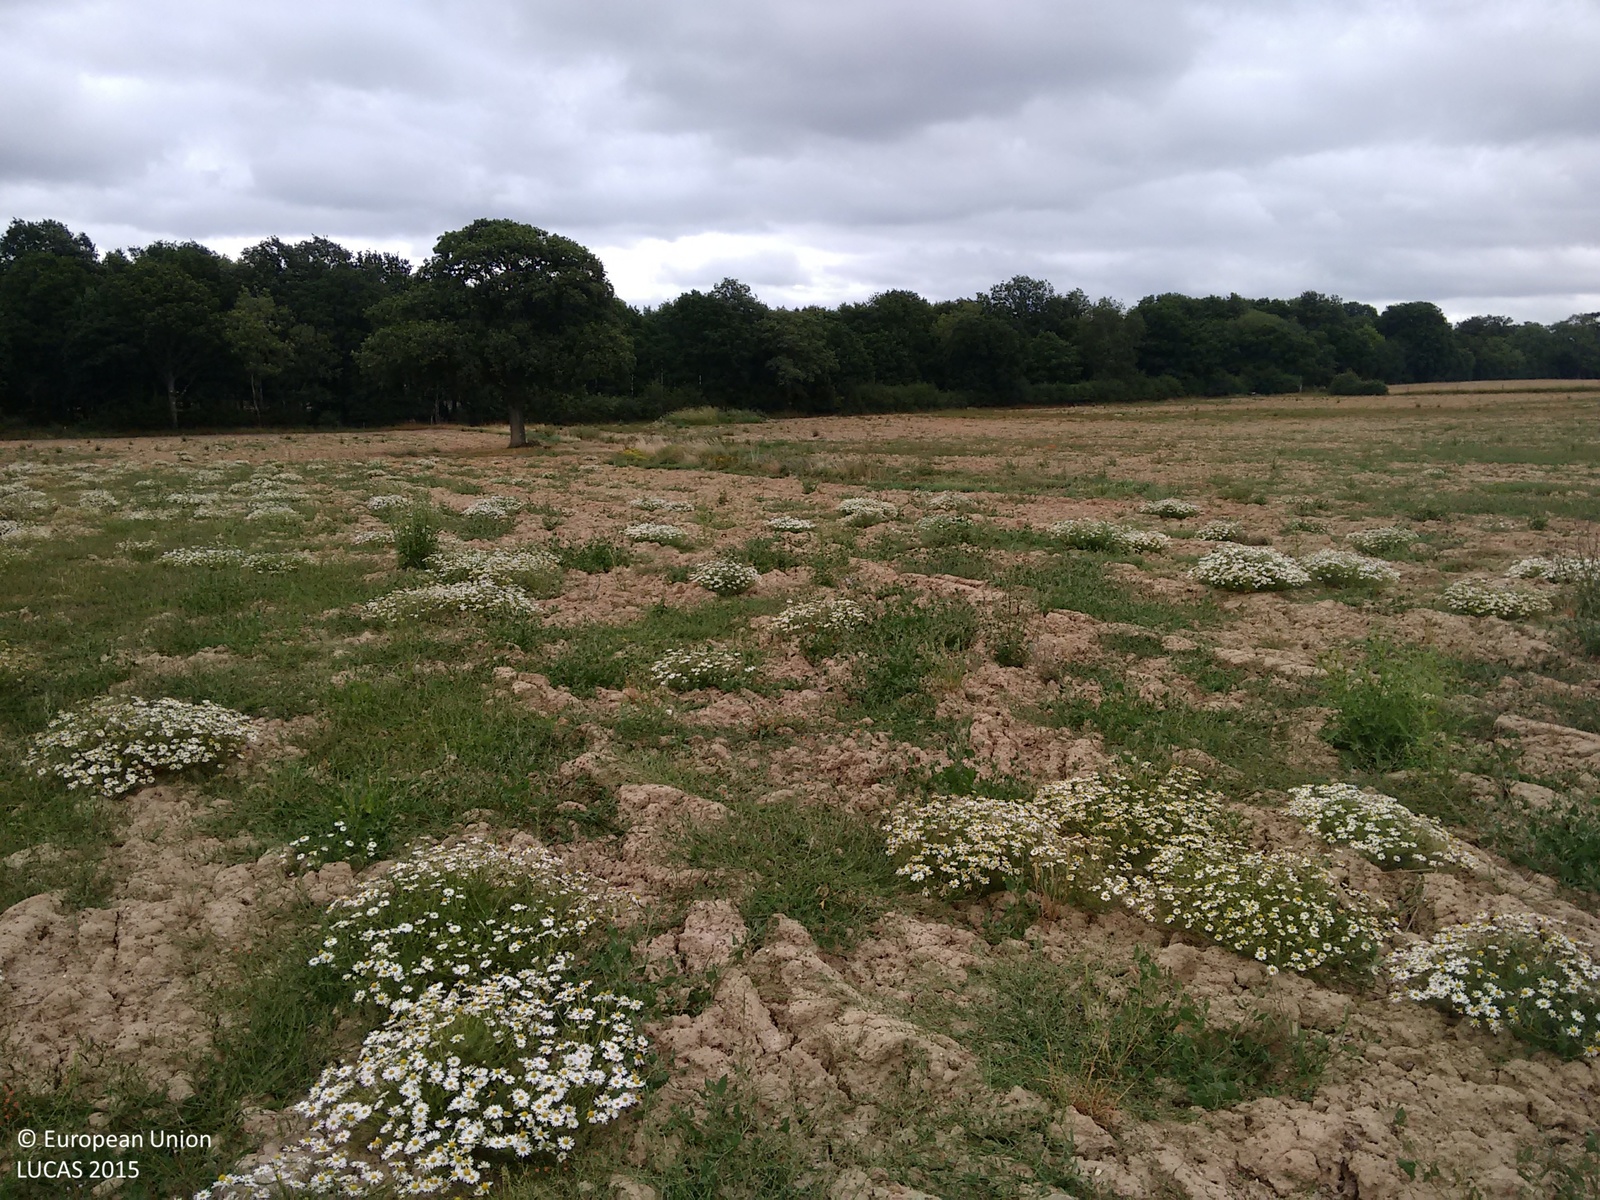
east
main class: Grassland
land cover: Spontaneously vegetated surfaces
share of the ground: 25 - 50 %
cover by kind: herbaceous plants 60 %, unconsolidated bare surface 40 %
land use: Fallow land
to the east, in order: Spontaneously vegetated surfaces; Ditches and canals; Spontaneously vegetated surfaces; Fences; Managed hedges; Ditches and canals; Tracks; Broadleaved woodland; Tracks; Broadleaved woodland; Fences; Shruby margins; Tracks; Broadleaved woodland
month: July
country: GB
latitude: 51.0940
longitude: -0.5046
